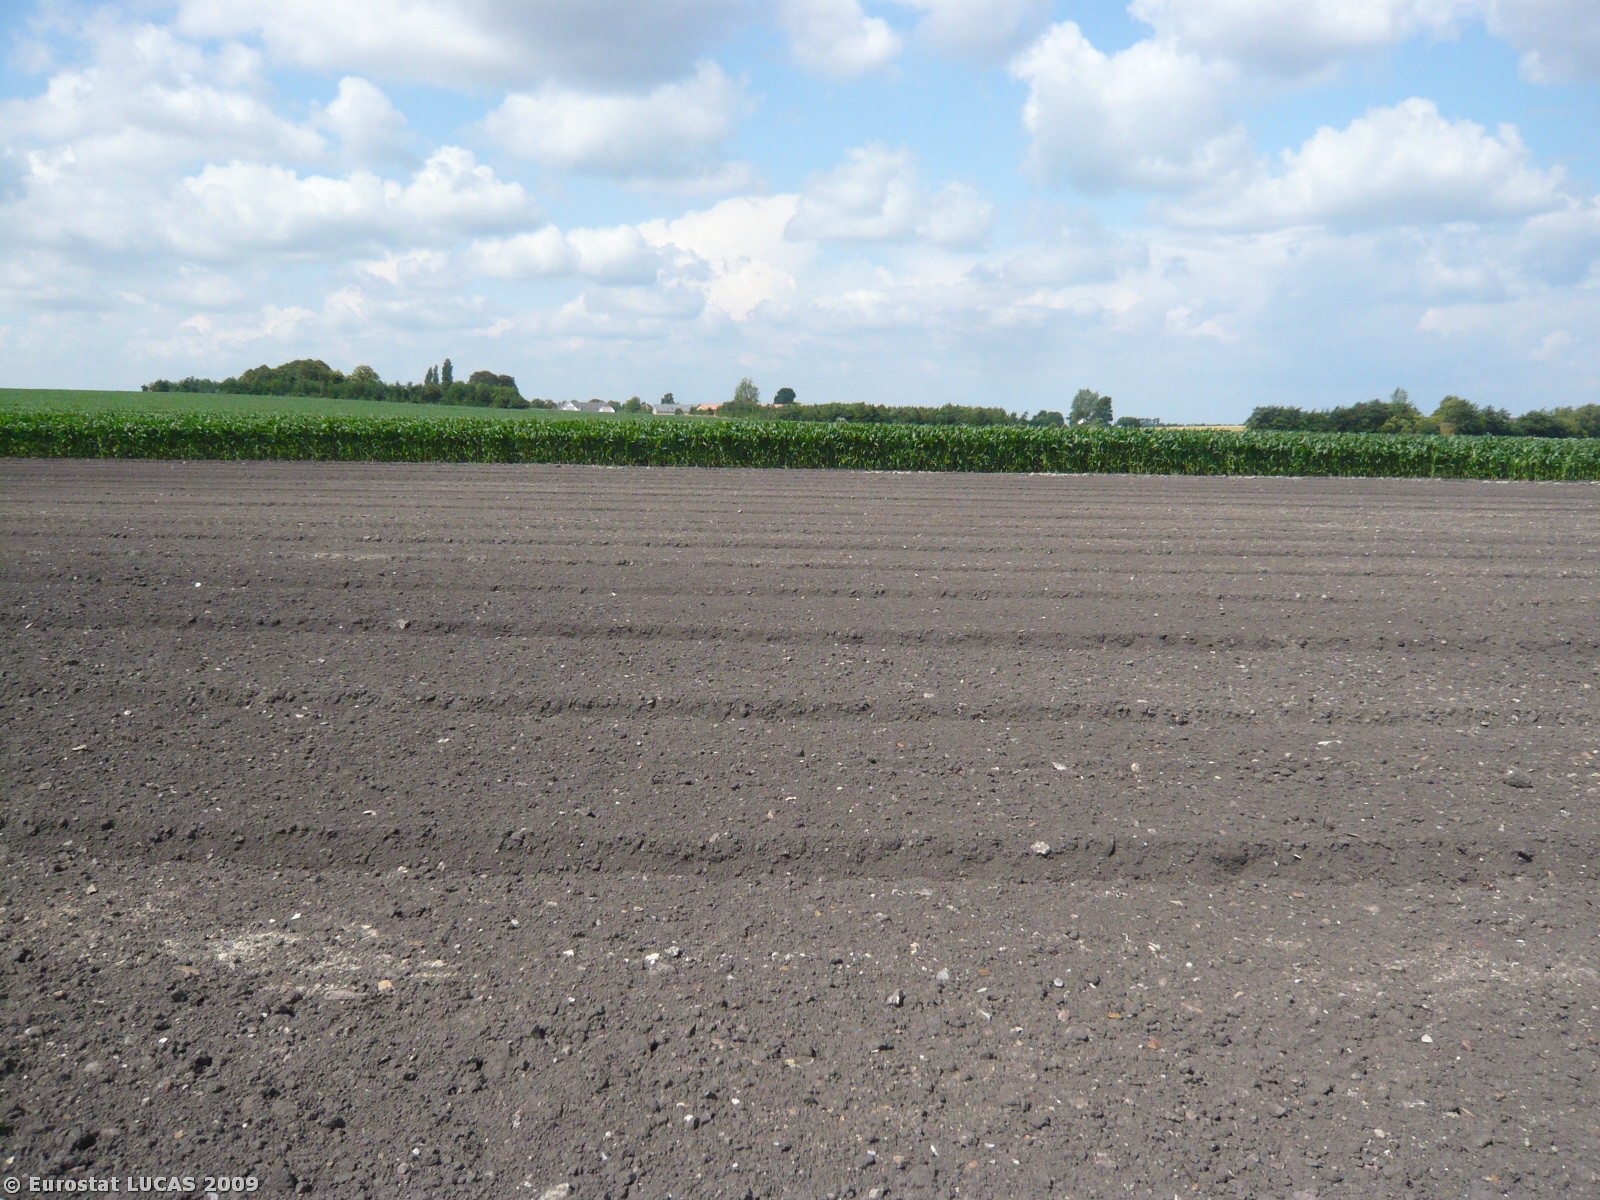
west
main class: Cropland
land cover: Other fresh vegetables
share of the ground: < 10 %
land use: Agriculture (excluding fallow land and kitchen gardens)
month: July
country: DK
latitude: 55.5943
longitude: 10.2695
